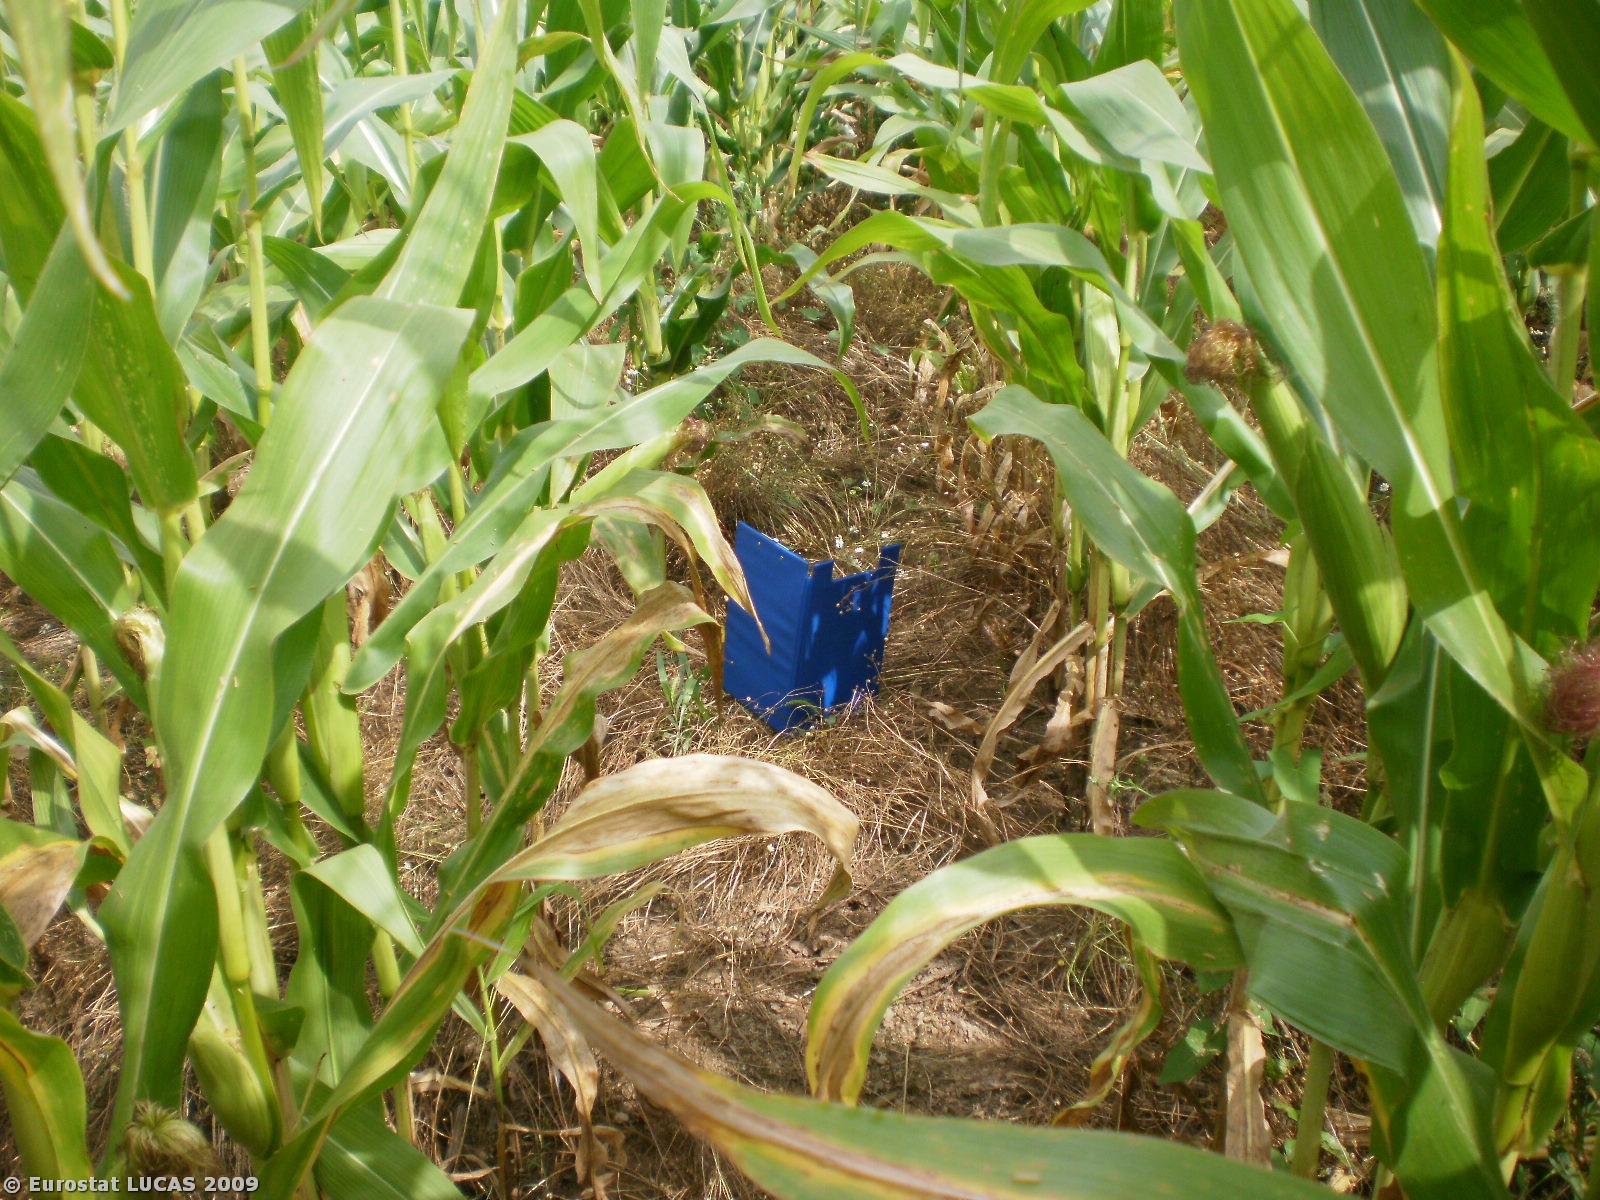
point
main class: Cropland
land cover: Maize
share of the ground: > 75 %
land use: Agriculture (excluding fallow land and kitchen gardens)
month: August
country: BE
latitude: 50.4412
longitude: 5.5911
